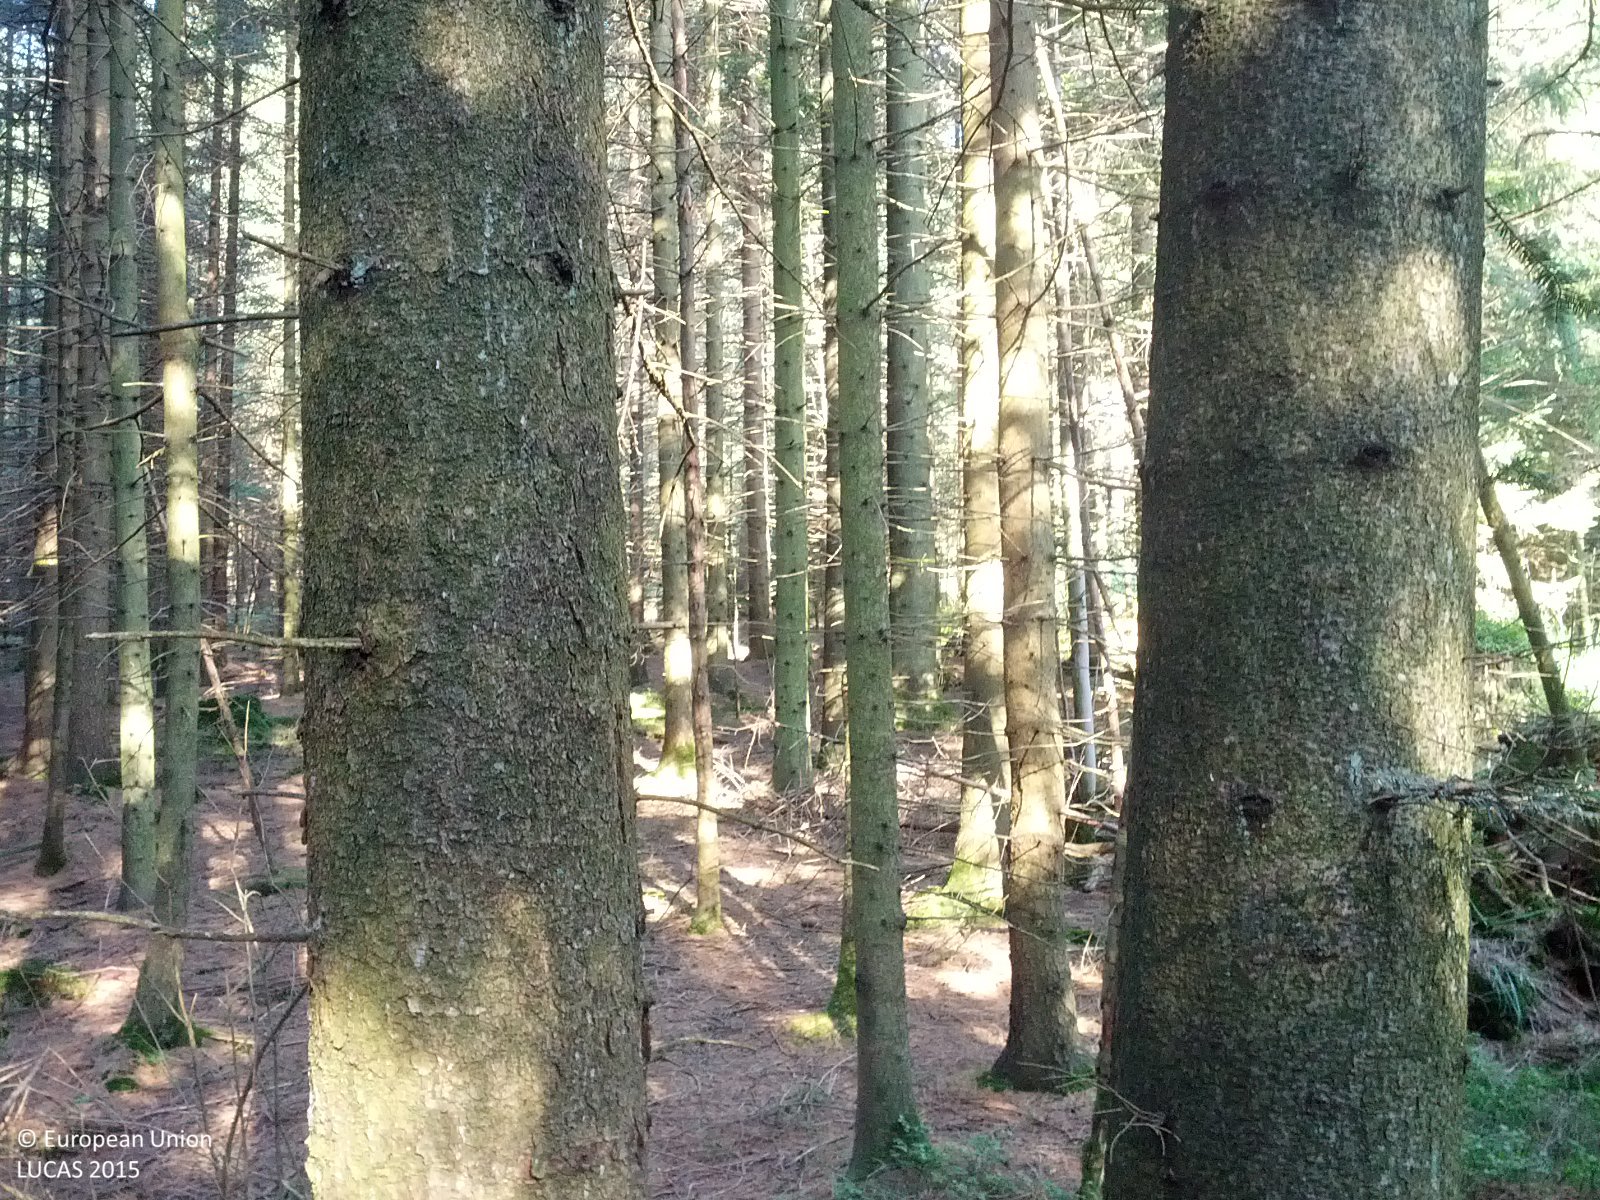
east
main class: Woodland
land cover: Spruce dominated coniferous woodland
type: alpine coniferous forest
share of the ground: > 75 %
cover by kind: coniferous forest trees 95 %, lichens and mosses 5 %
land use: Forestry
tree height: > 5 m
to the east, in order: Spruce dominated coniferous woodland; Tracks; Spruce dominated coniferous woodland; Tracks; Spruce dominated coniferous woodland
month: September
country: AT
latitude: 48.0281
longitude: 13.3649
